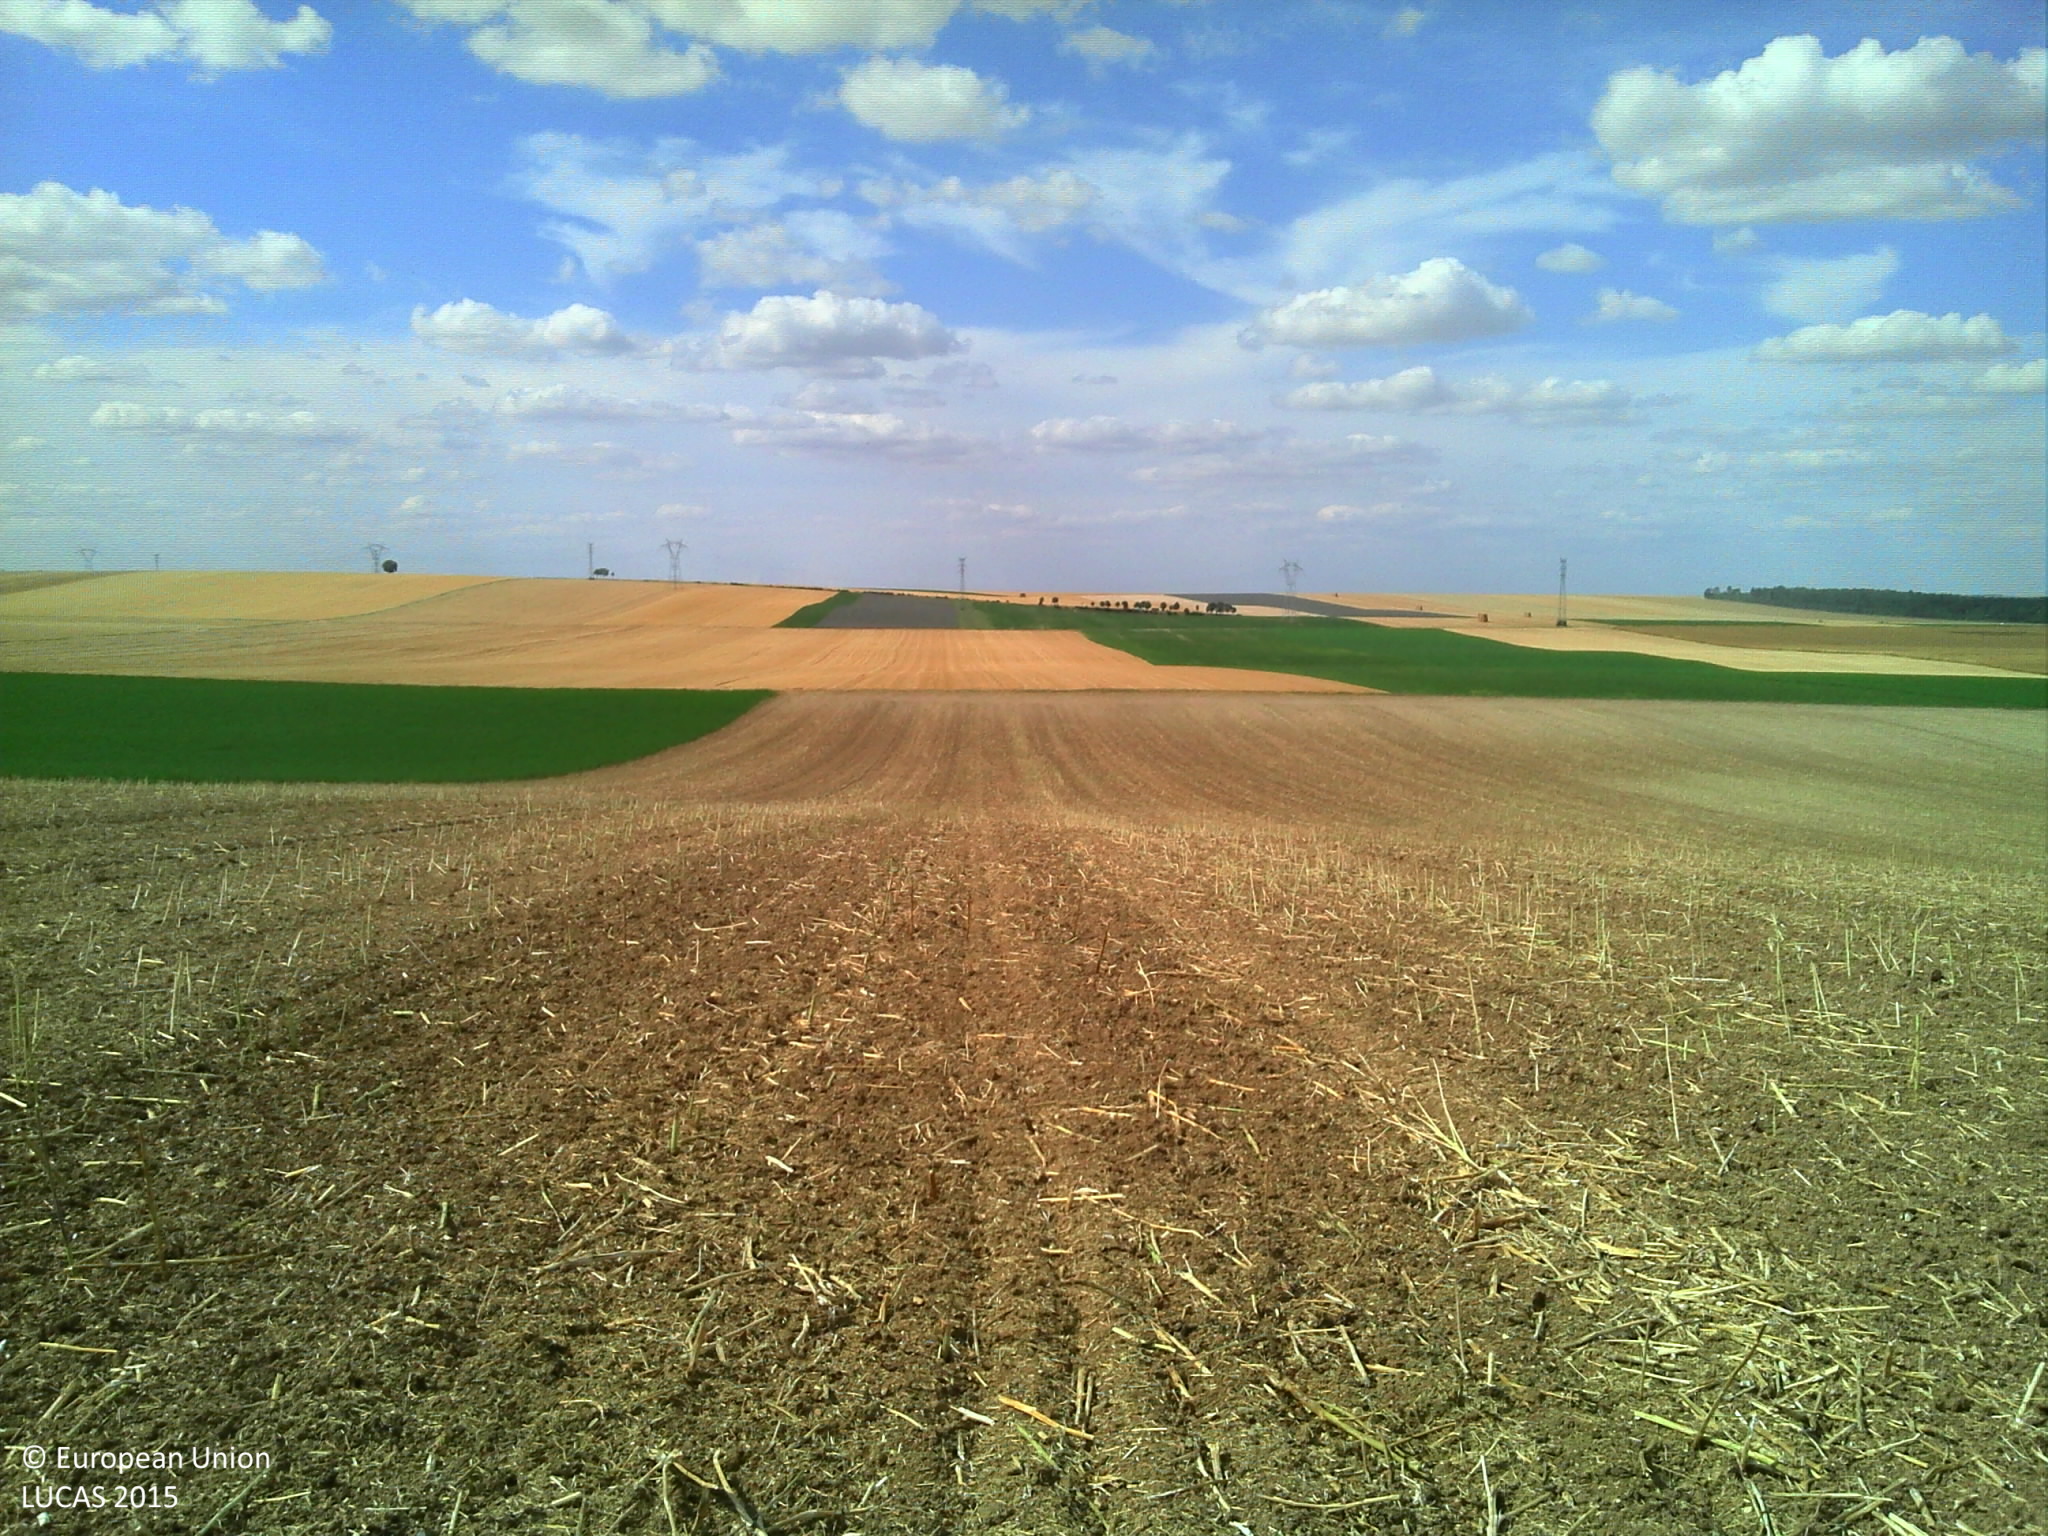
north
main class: Cropland
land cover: Rape and turnip rape
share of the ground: > 75 %
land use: Agriculture (excluding fallow land and kitchen gardens)
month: July
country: FR
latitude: 49.2604
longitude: 4.1831
